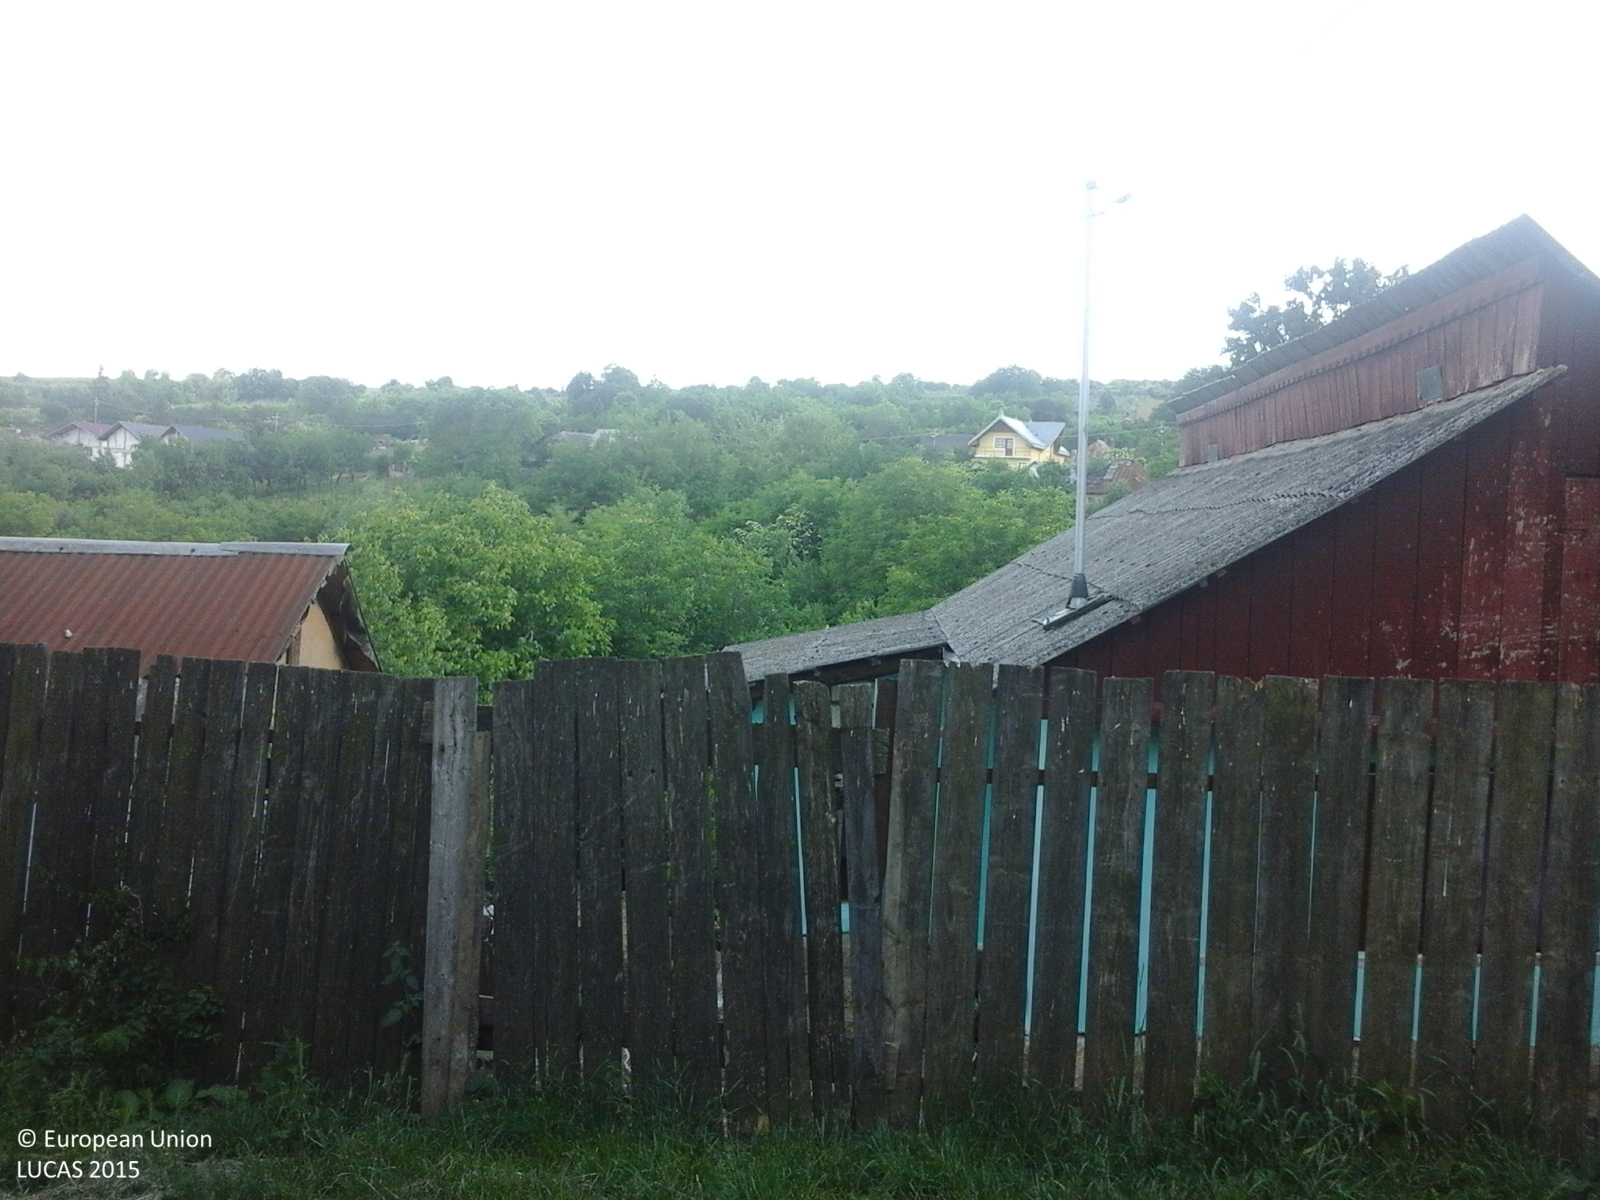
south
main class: Cropland
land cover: Other fresh vegetables
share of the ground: < 10 %
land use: Kitchen garden
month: June
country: RO
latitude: 46.4292
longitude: 26.8926
